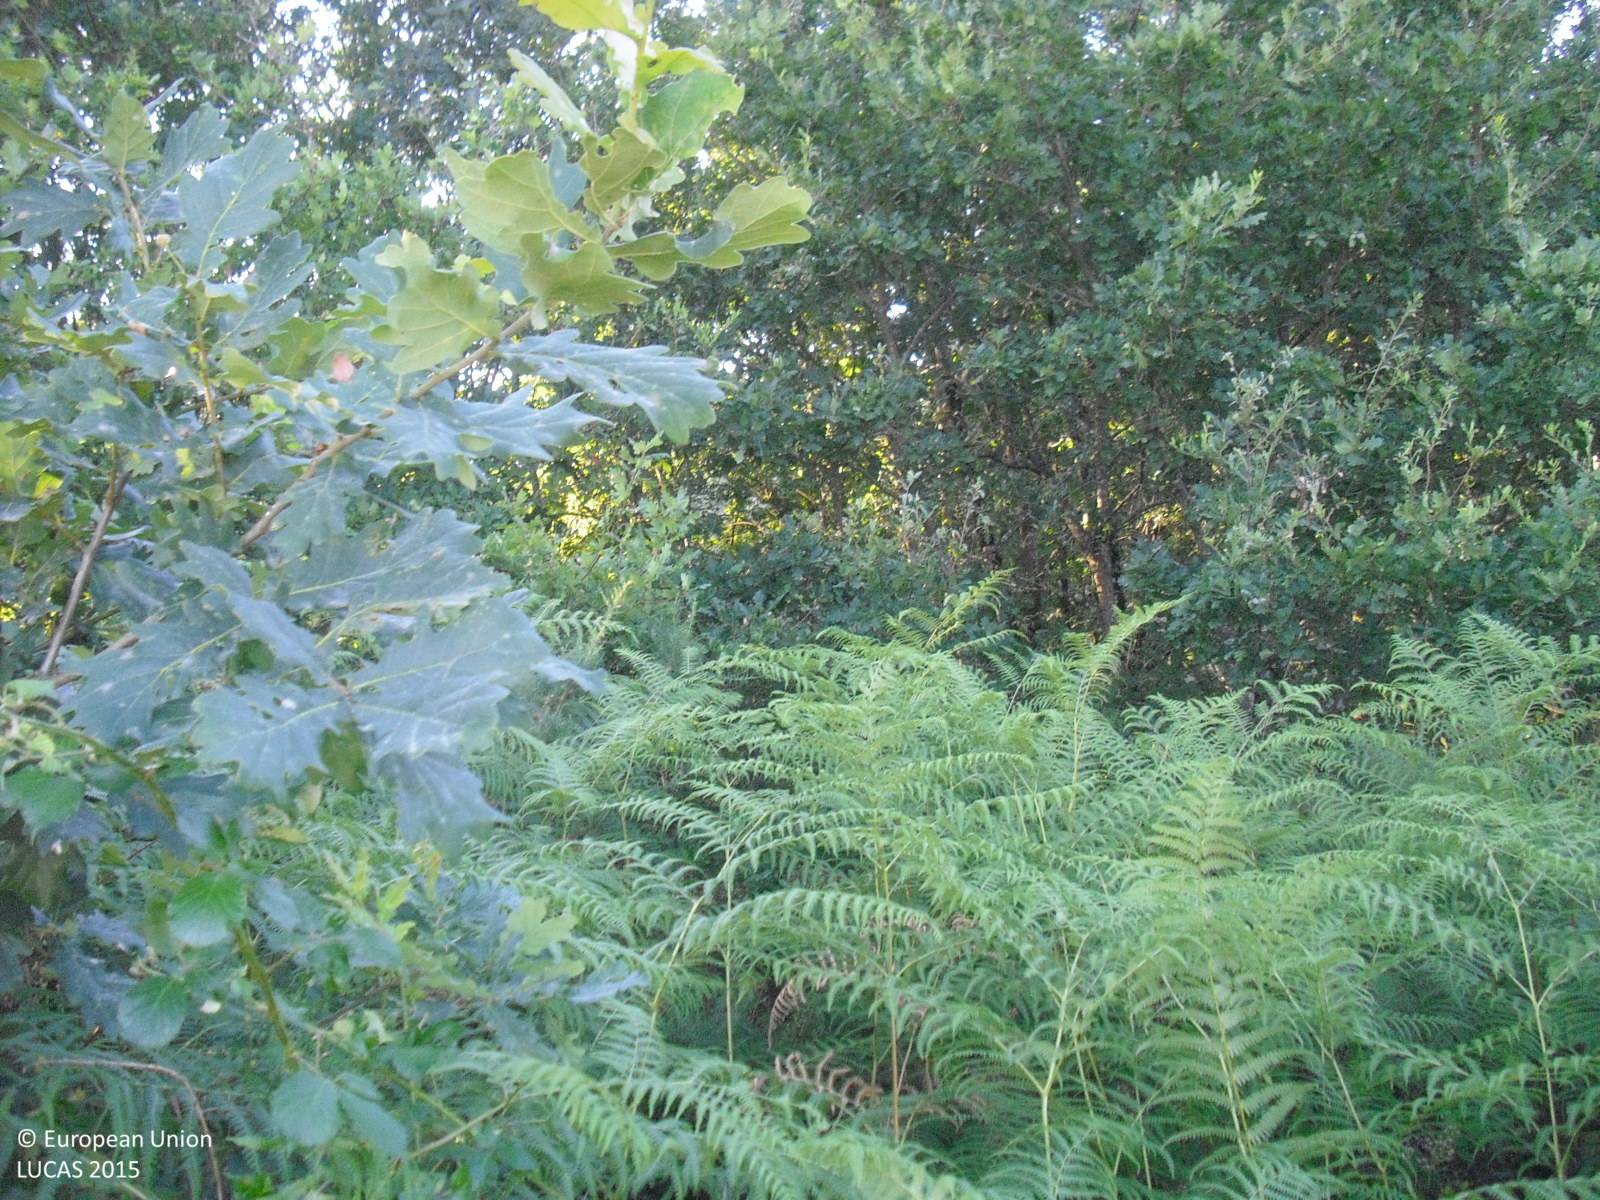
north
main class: Woodland
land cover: Broadleaved woodland
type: acidophilous oak and oak-birch forest
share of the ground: 25 - 50 %
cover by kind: shrubs 55 %, broadleaved forest trees 40 %, coniferous forest trees 5 %
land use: Semi-natural and natural areas not in use
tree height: > 5 m
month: July
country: ES
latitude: 42.6330
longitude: -7.4715
